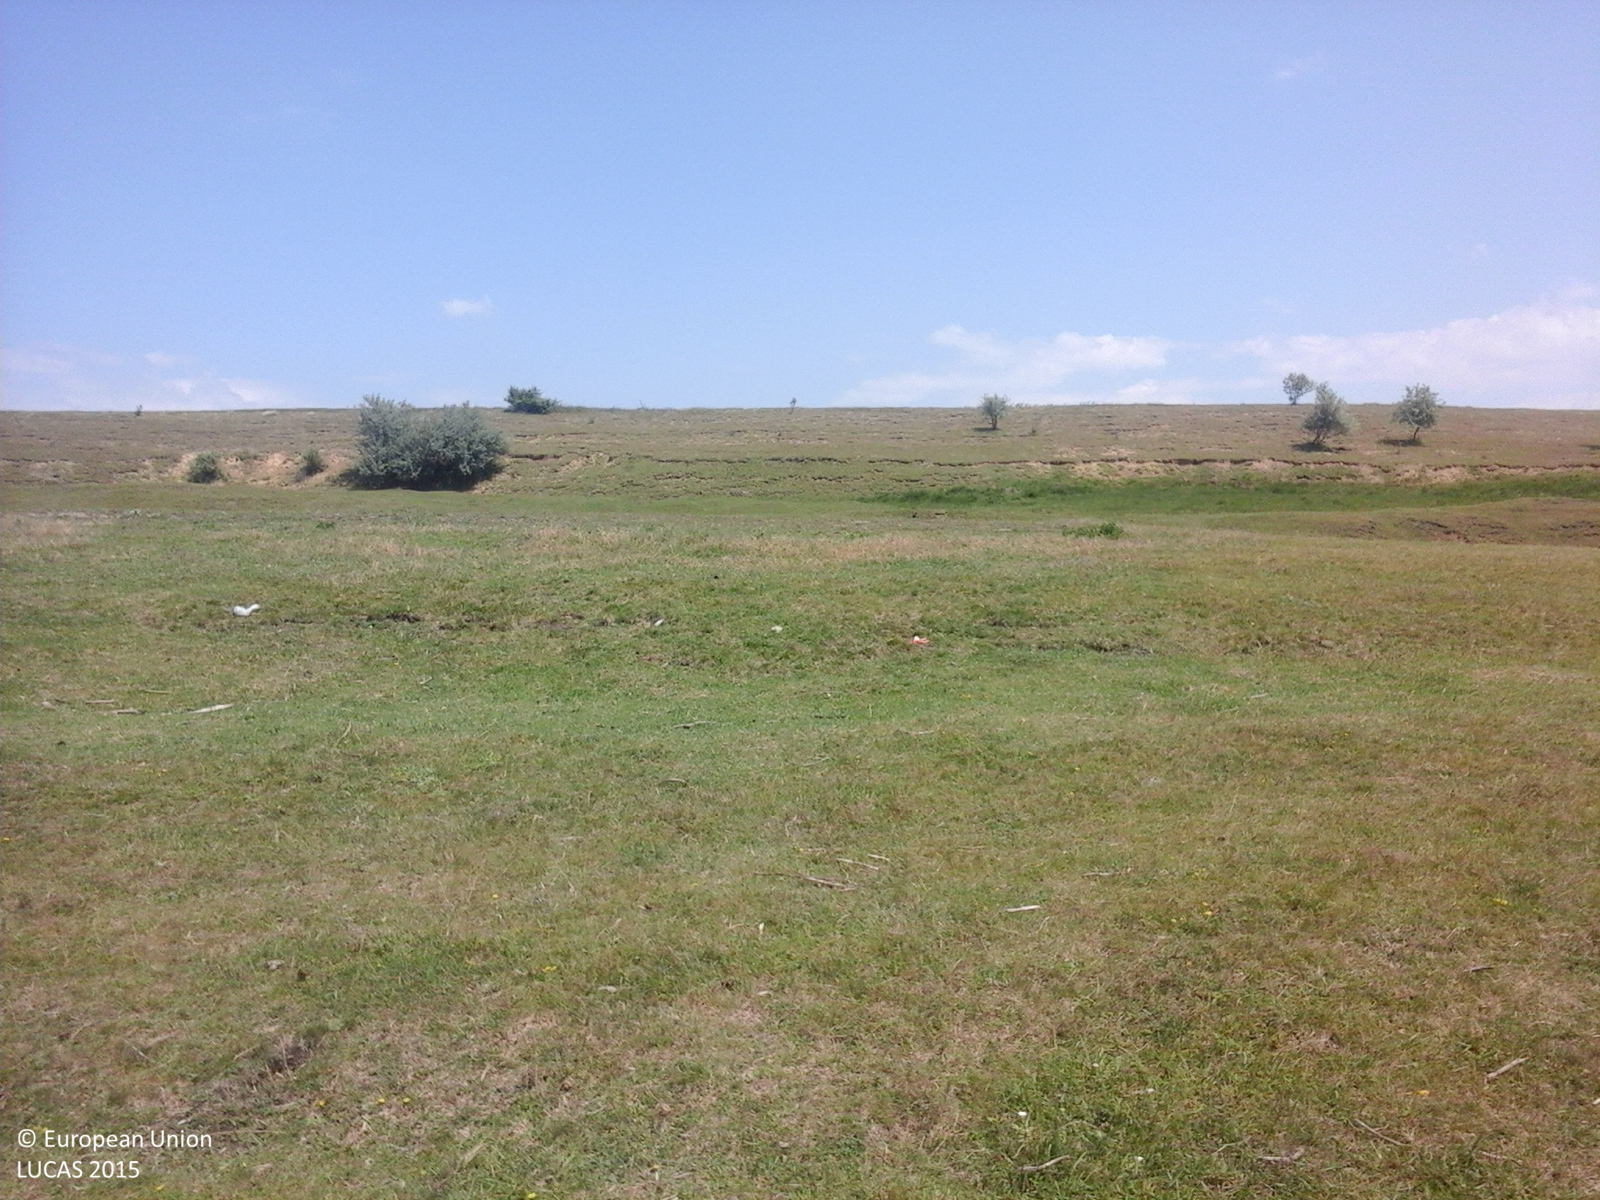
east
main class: Grassland
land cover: Grassland without tree/shrub cover
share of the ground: > 75 %
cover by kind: herbaceous plants 100 %
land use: Agriculture (excluding fallow land and kitchen gardens)
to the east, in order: Grassland without tree/shrub cover; Grassland with sparse tree/shrub cover; Maize; Soya; Maize
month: June
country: RO
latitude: 48.0375
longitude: 26.7162
